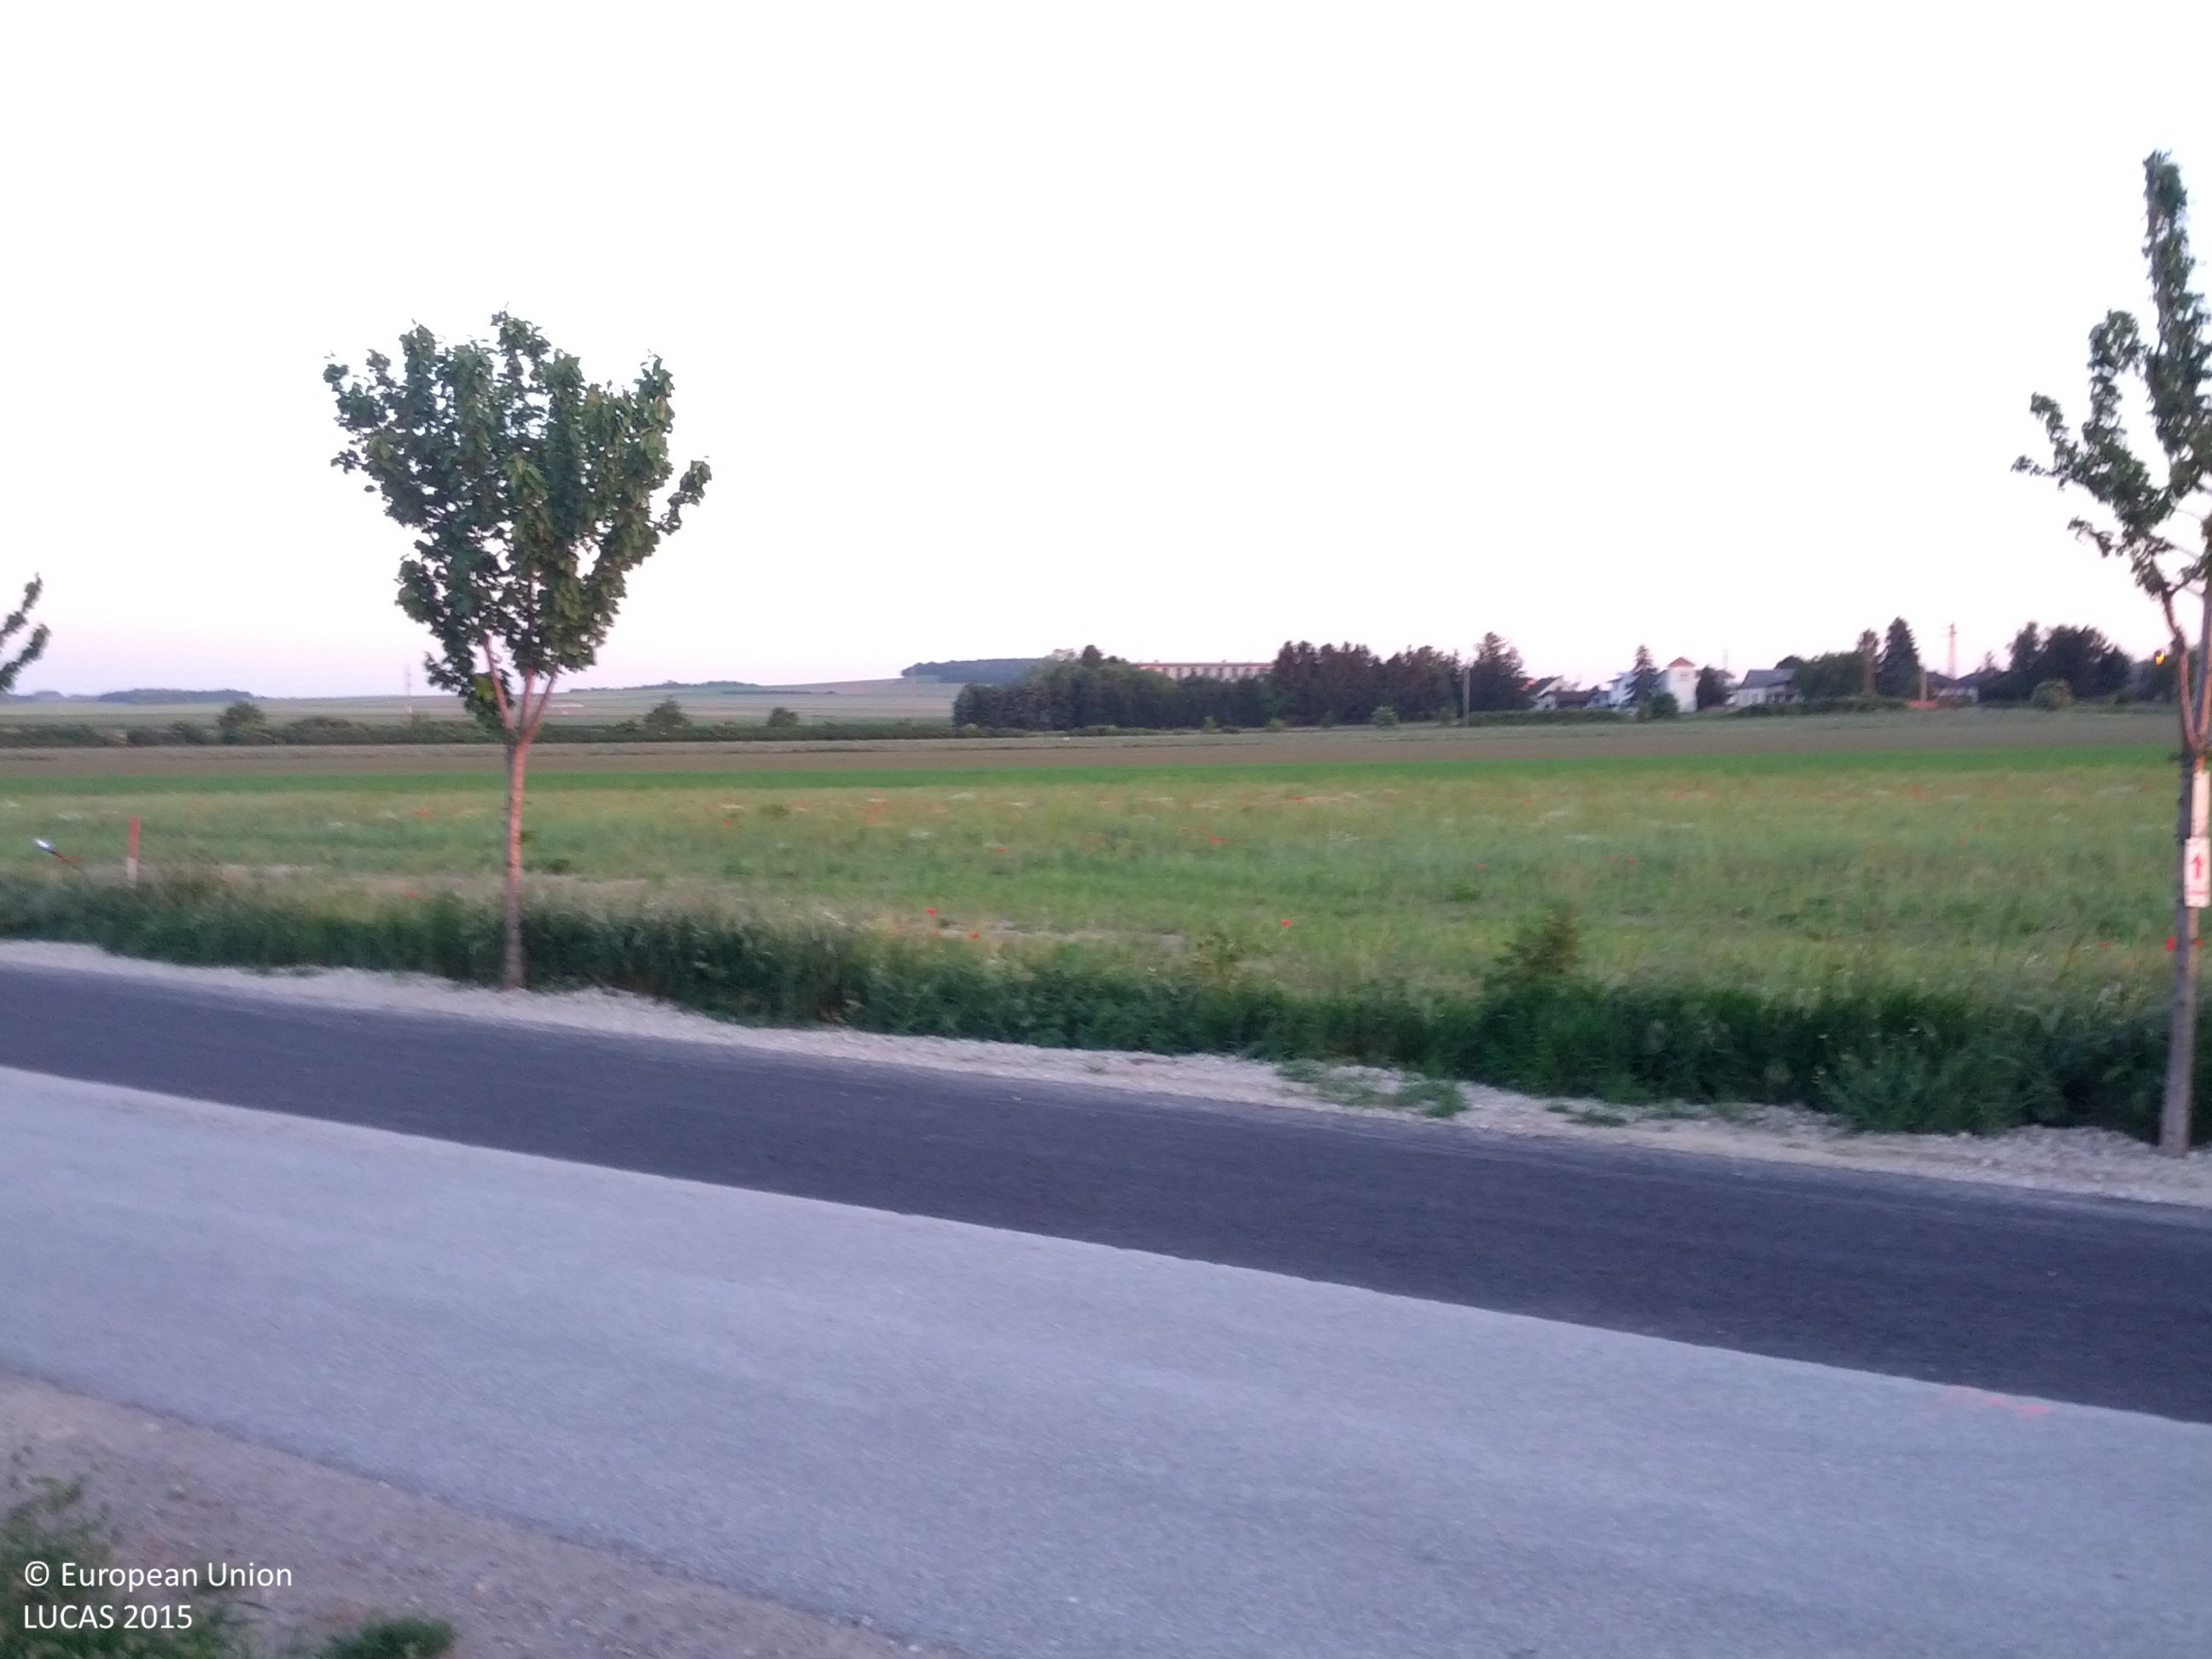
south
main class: Cropland
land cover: Common wheat
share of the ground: > 75 %
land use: Agriculture (excluding fallow land and kitchen gardens)
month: May
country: AT
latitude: 48.1143
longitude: 16.6278
